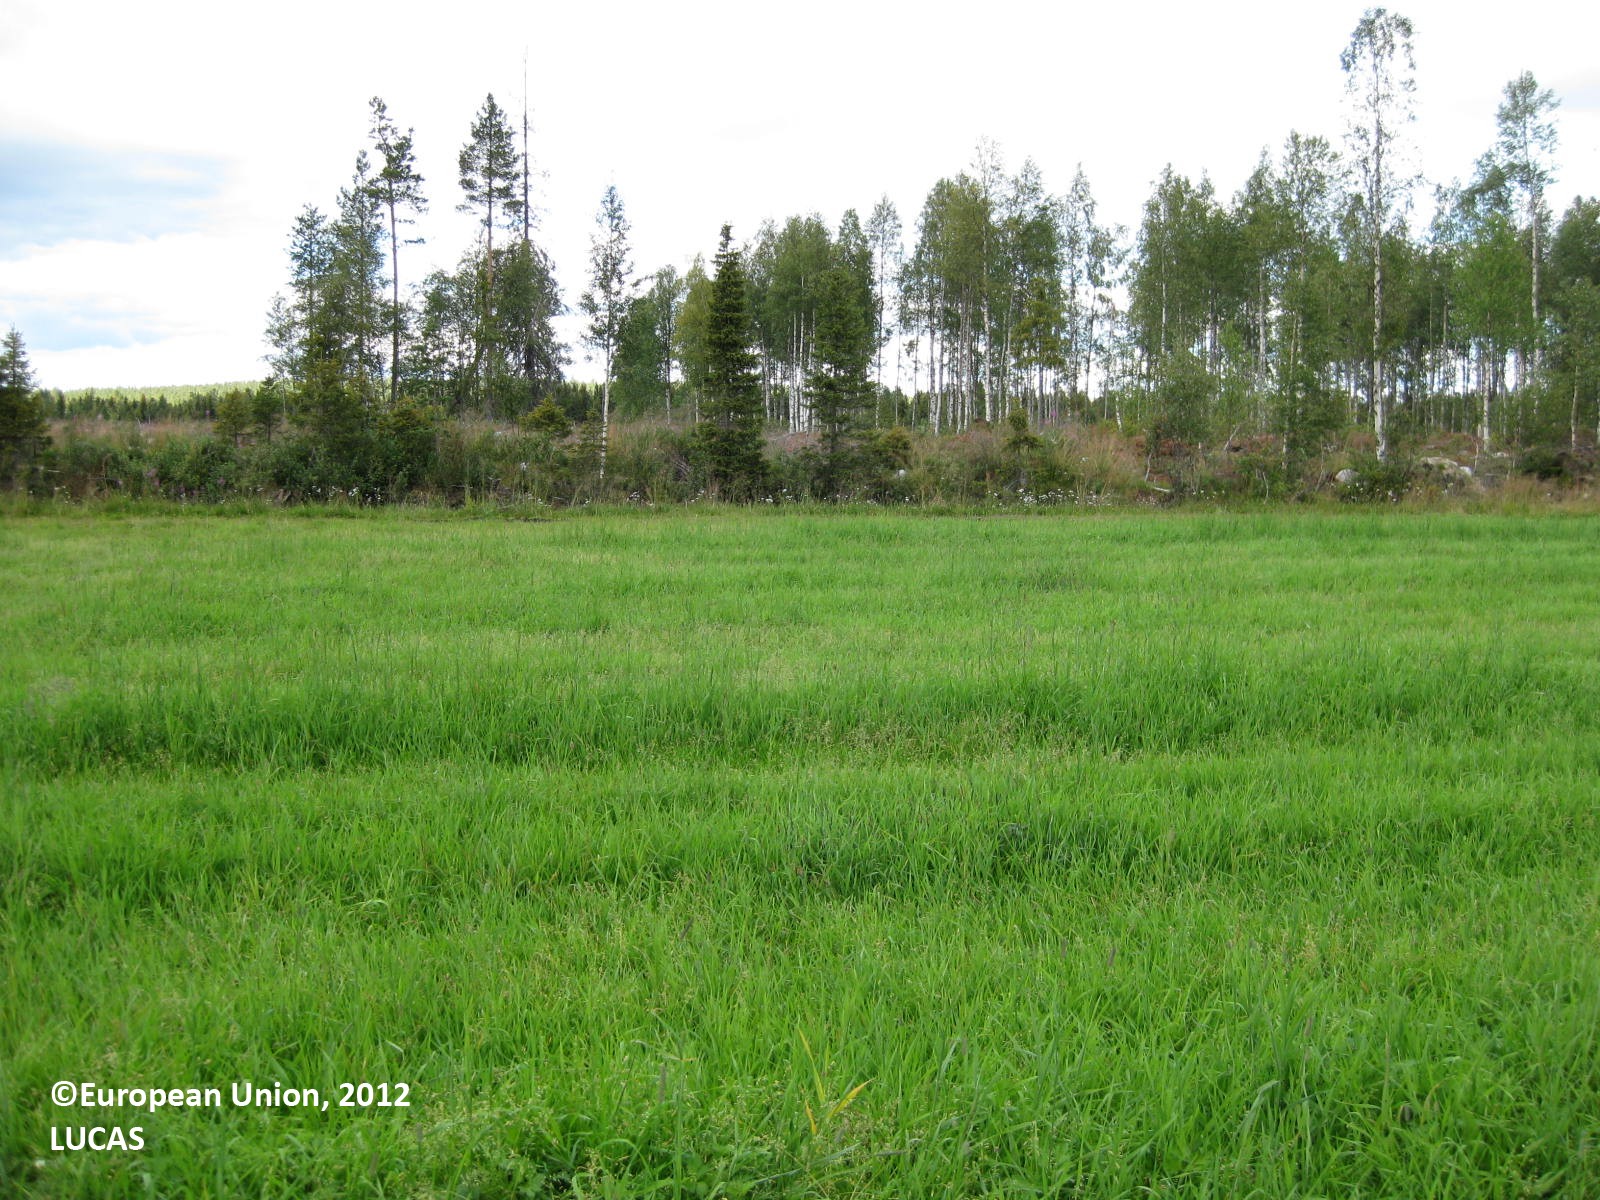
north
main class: Cropland
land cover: Temporary grasslands
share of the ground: > 75 %
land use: Agriculture (excluding fallow land and kitchen gardens)
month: August
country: FI
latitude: 66.4359
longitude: 28.5061
